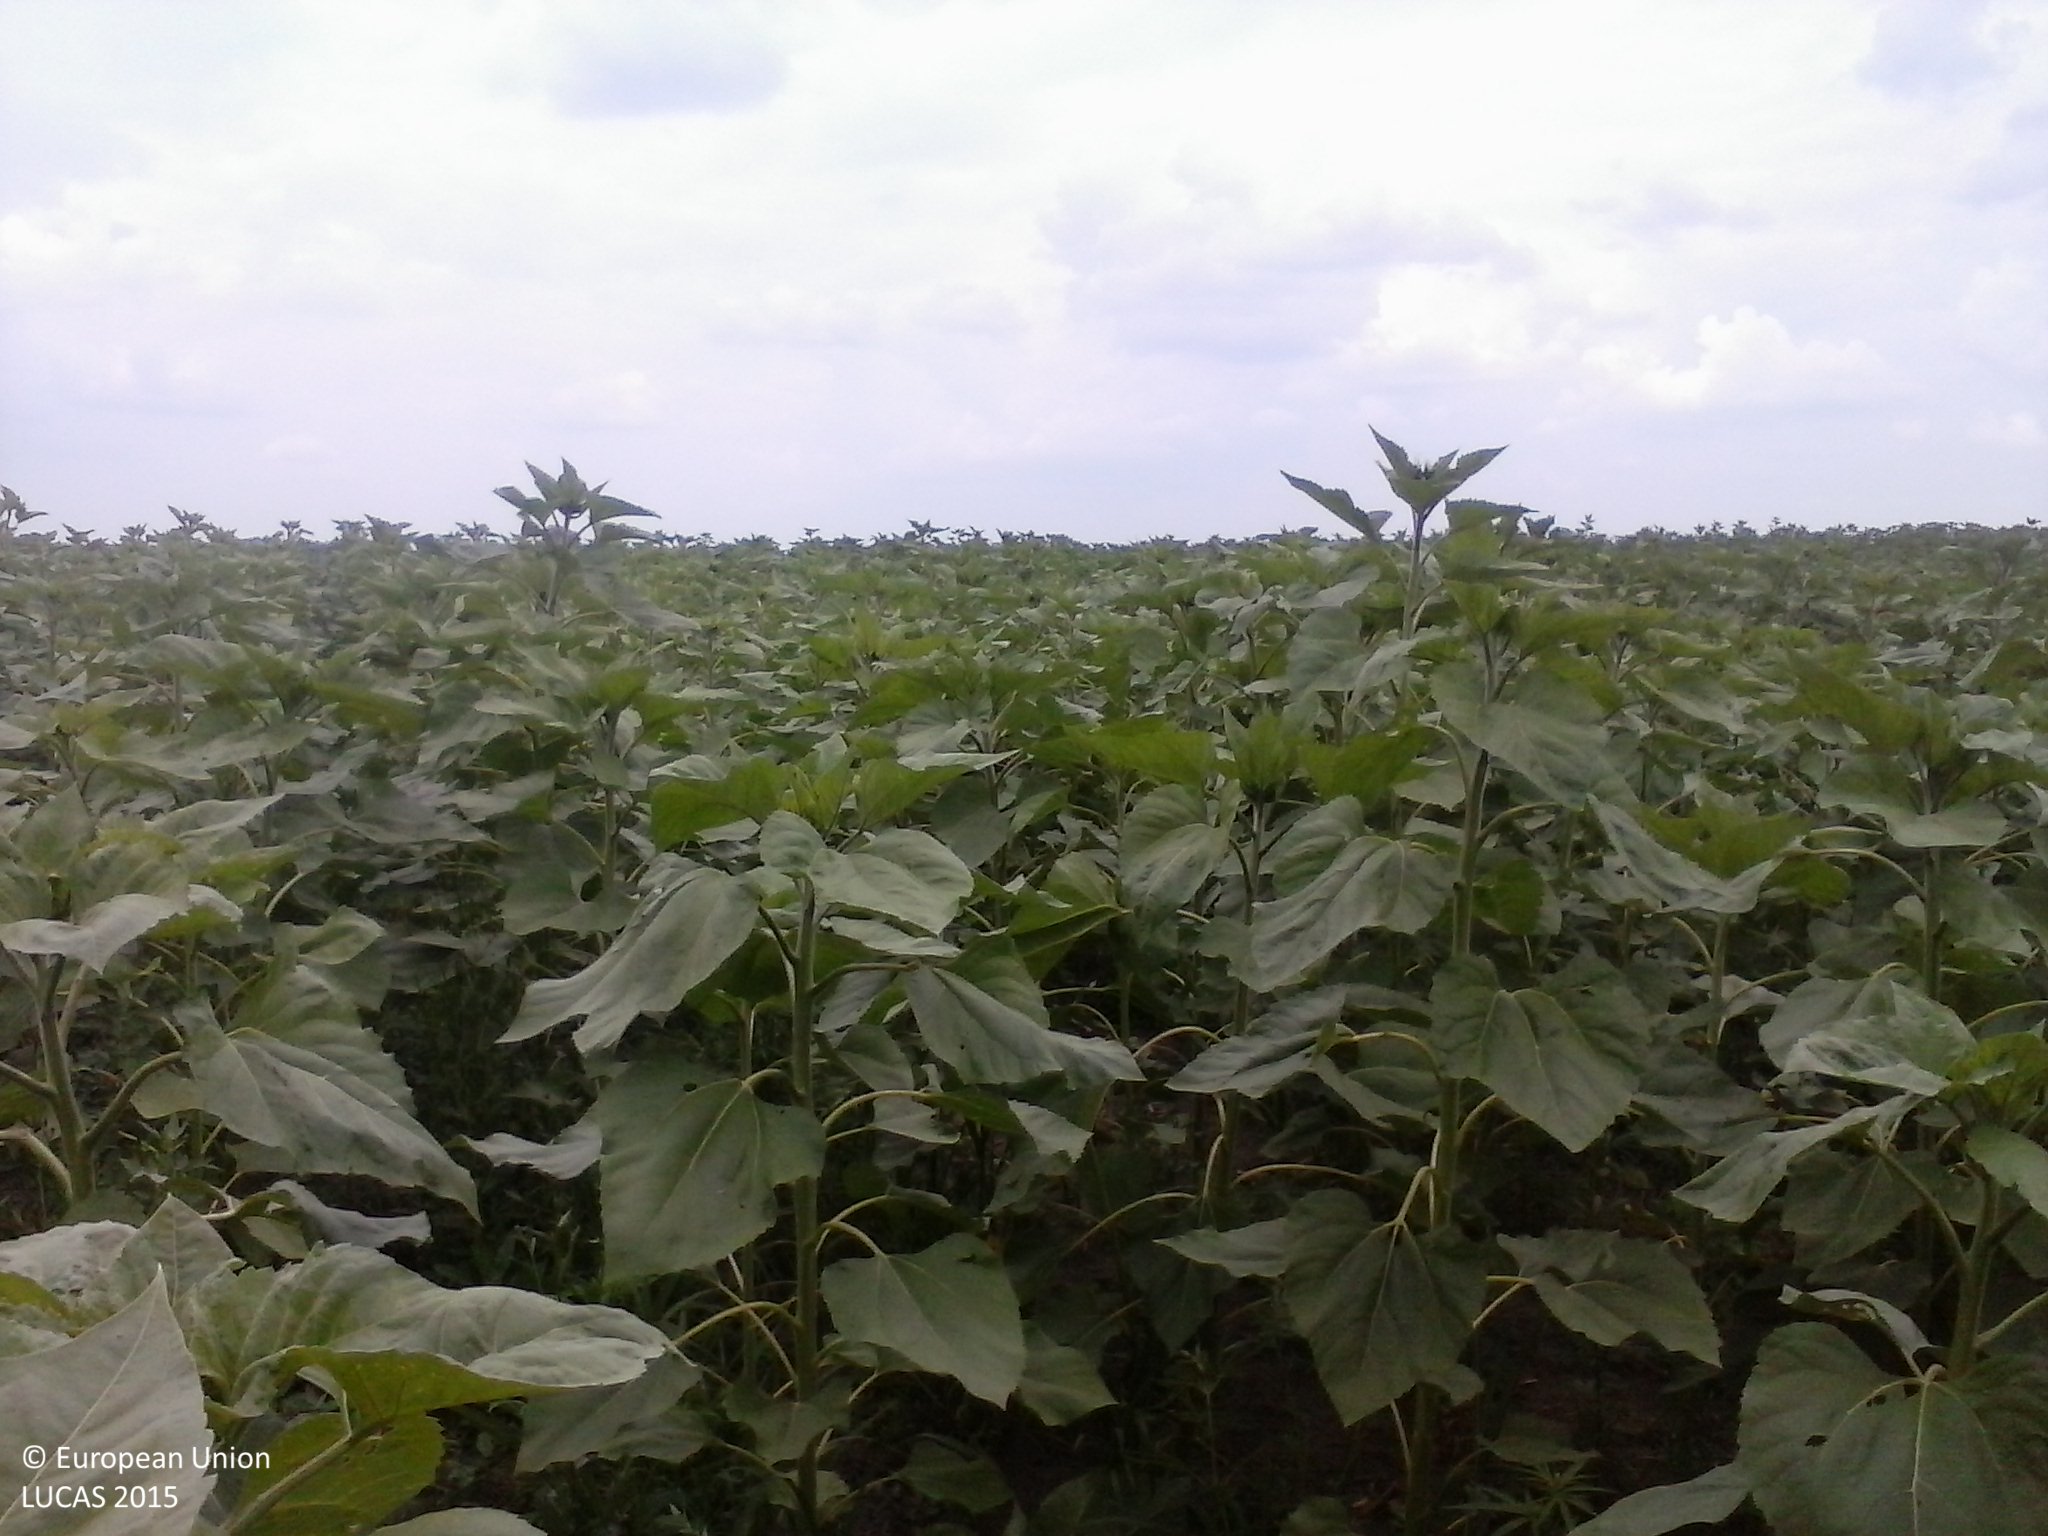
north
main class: Cropland
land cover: Sunflower
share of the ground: > 75 %
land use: Agriculture (excluding fallow land and kitchen gardens)
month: June
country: HU
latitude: 46.2494
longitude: 19.5503
